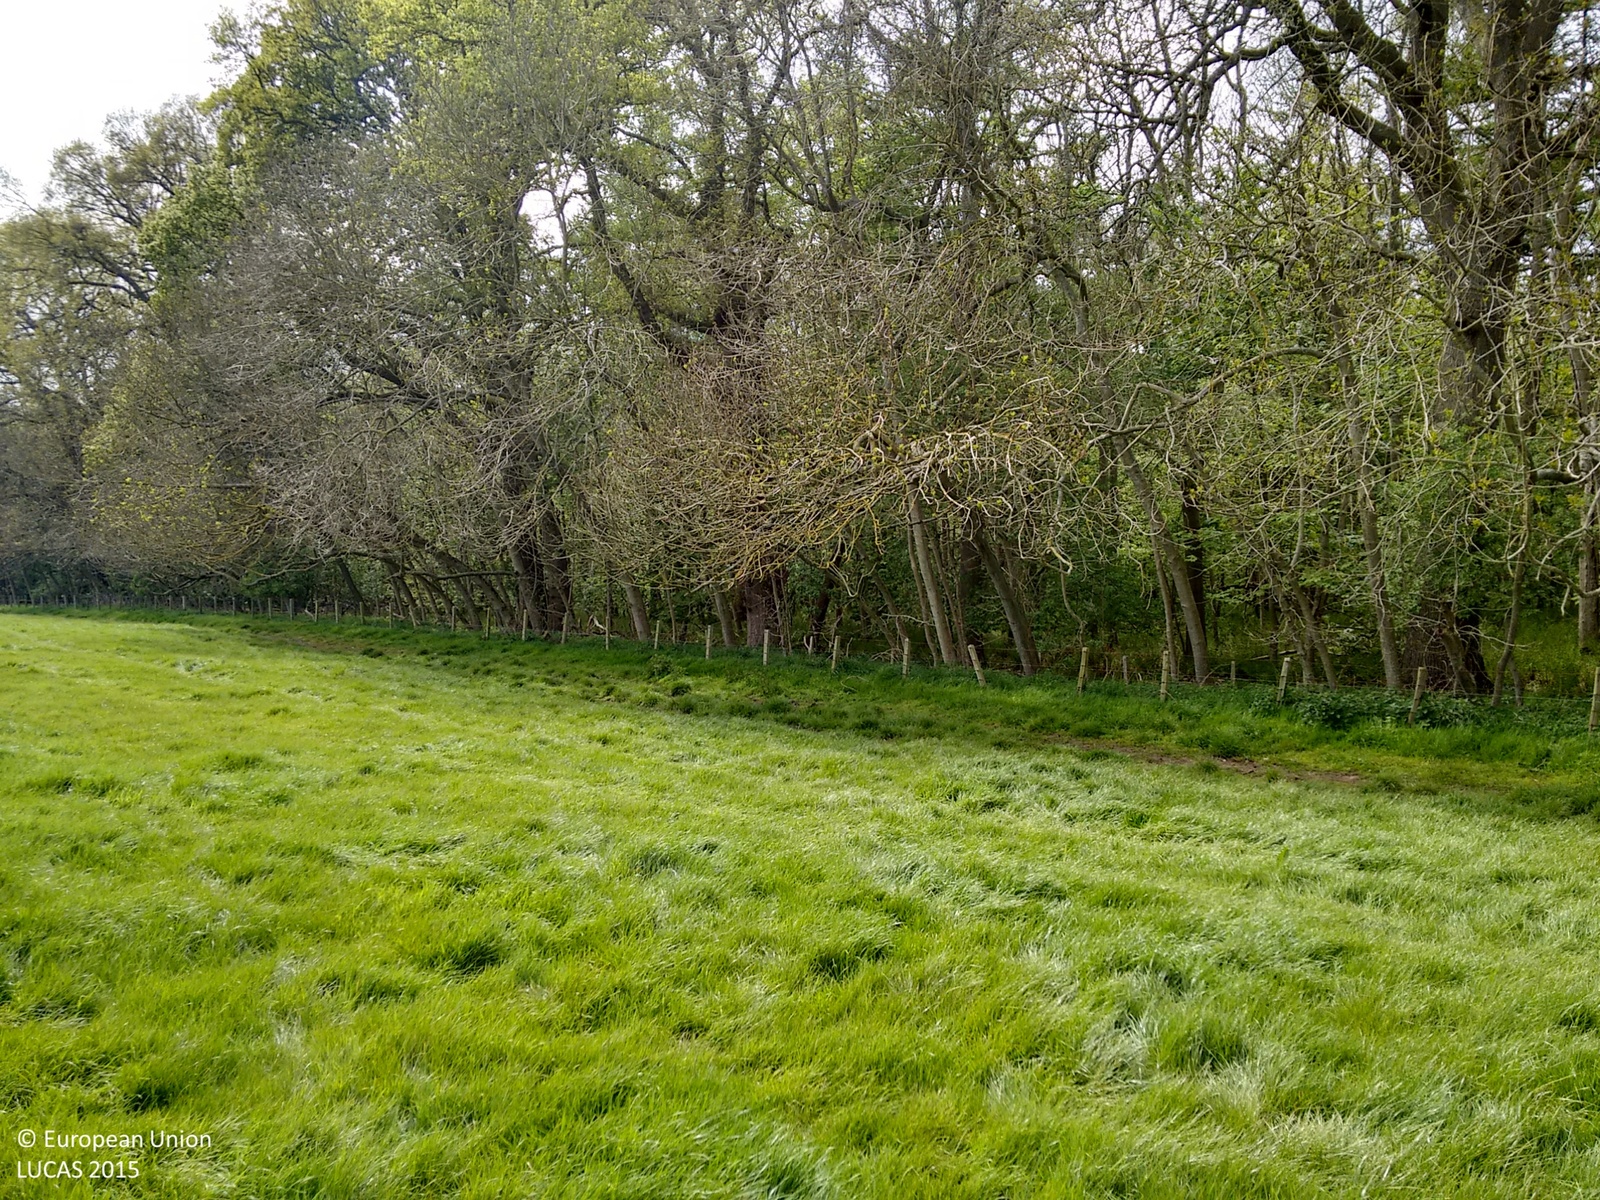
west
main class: Grassland
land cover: Grassland without tree/shrub cover
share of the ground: > 75 %
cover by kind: herbaceous plants 100 %
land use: Agriculture (excluding fallow land and kitchen gardens)
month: May
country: GB
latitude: 55.6677
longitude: -2.2828
